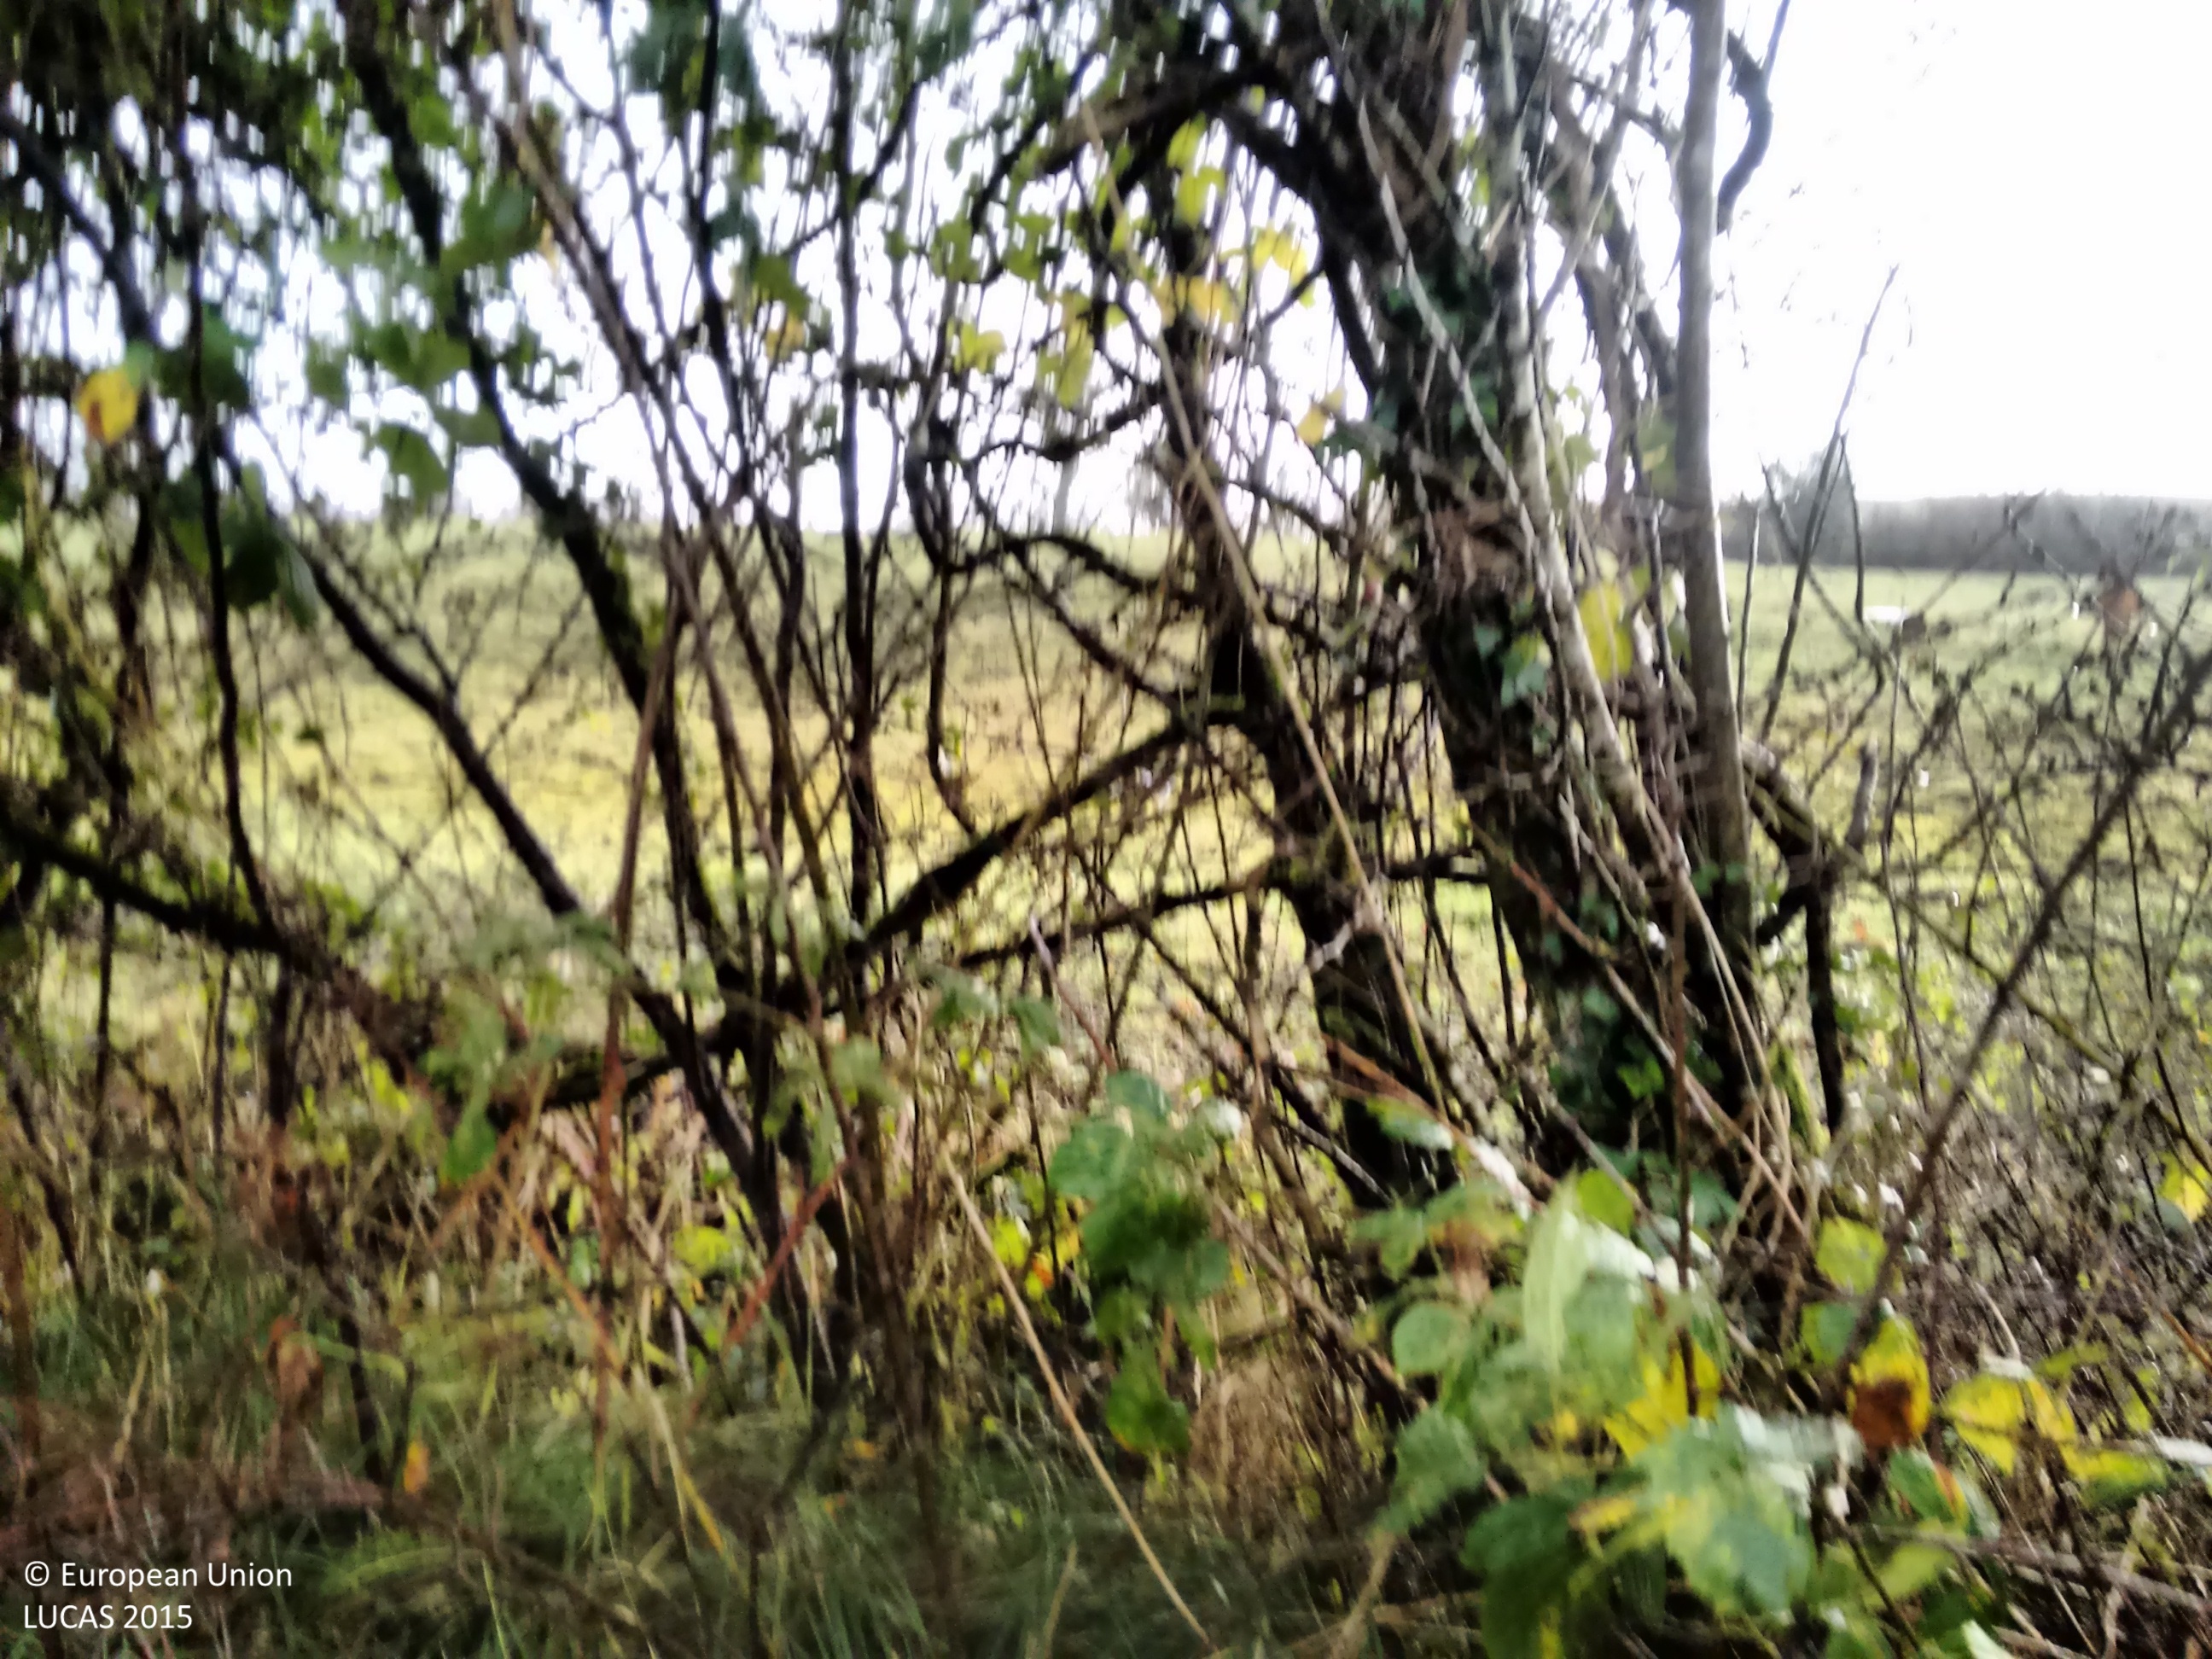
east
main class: Grassland
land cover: Grassland without tree/shrub cover
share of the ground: > 75 %
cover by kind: herbaceous plants 100 %
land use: Agriculture (excluding fallow land and kitchen gardens)
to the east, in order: Grassland without tree/shrub cover; Abandoned hedges; Grassland without tree/shrub cover; Abandoned hedges; Grassland without tree/shrub cover; Electric lines; Grassland without tree/shrub cover; Fences; Tracks; Abandoned hedges; Grassland without tree/shrub cover; Artificial constructions in urban areas
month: November
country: IE
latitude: 53.9446
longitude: -7.9524
